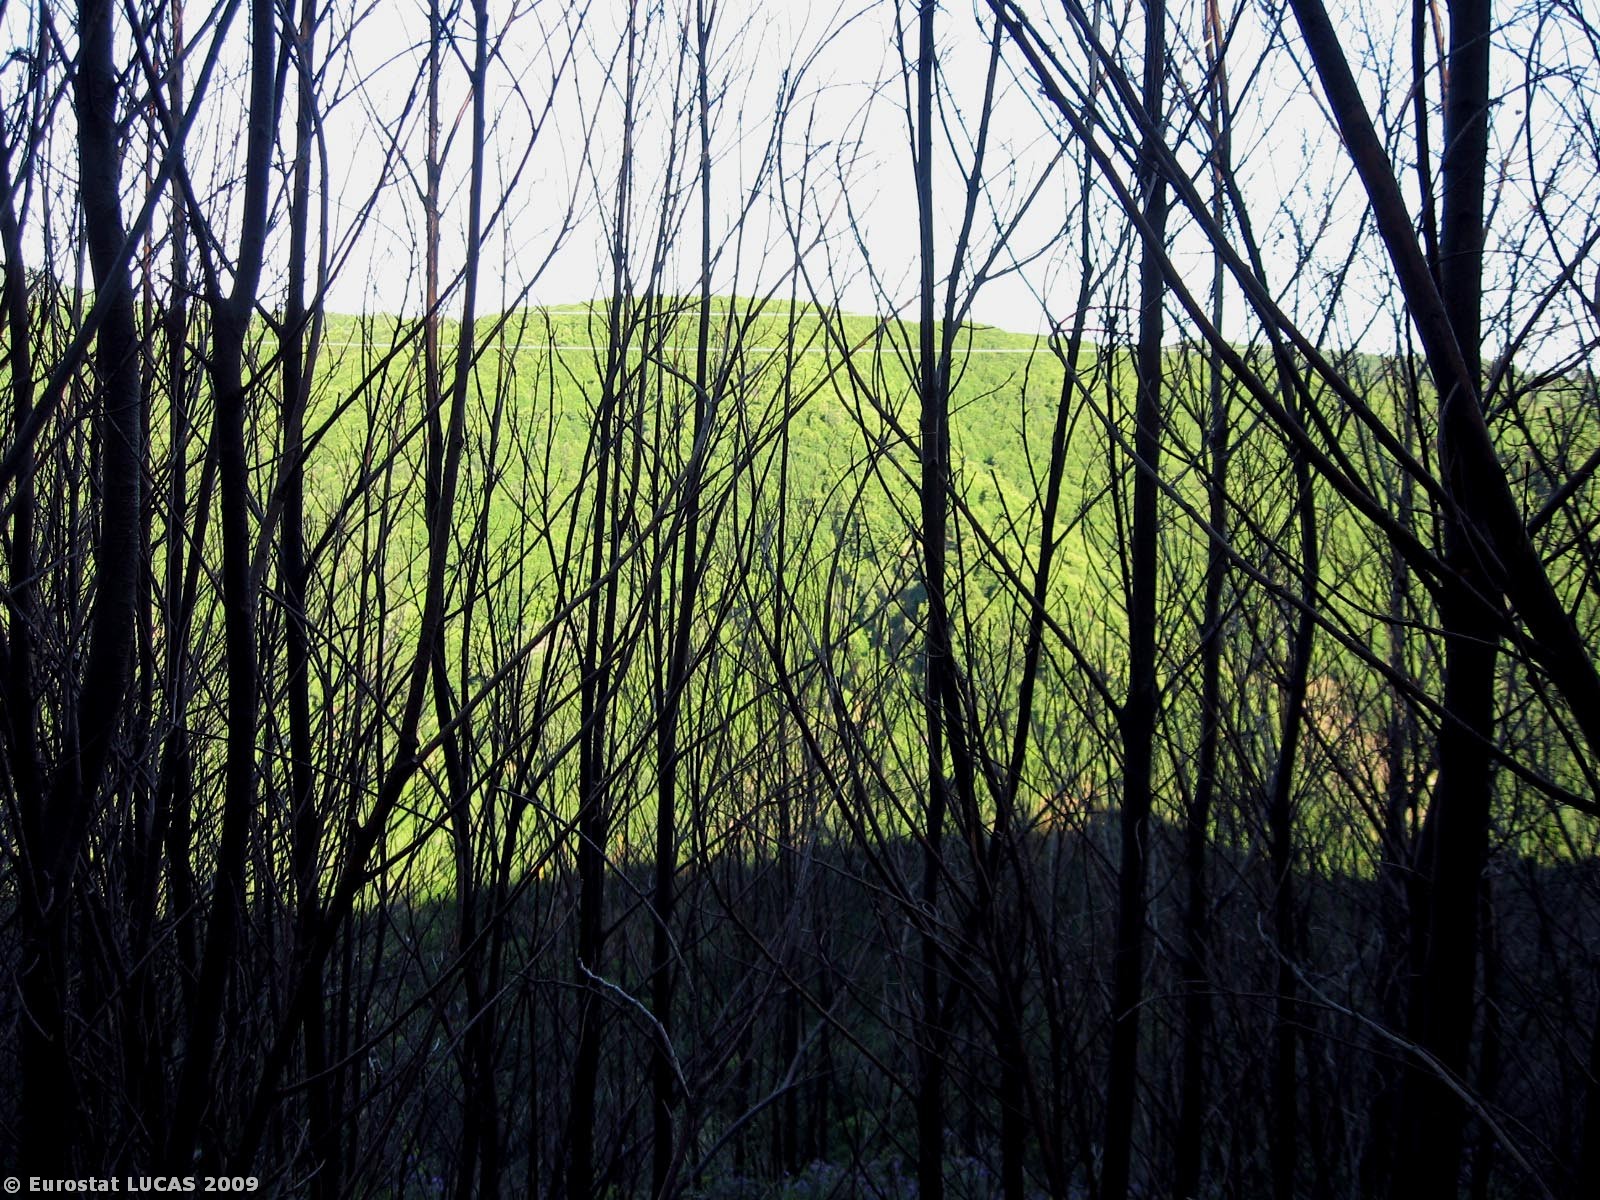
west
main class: Woodland
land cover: Broadleaved woodland
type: thermophilous deciduous forest
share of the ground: 25 - 50 %
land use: Forestry
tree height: > 5 m
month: June
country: IT
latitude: 38.8228
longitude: 16.4045
